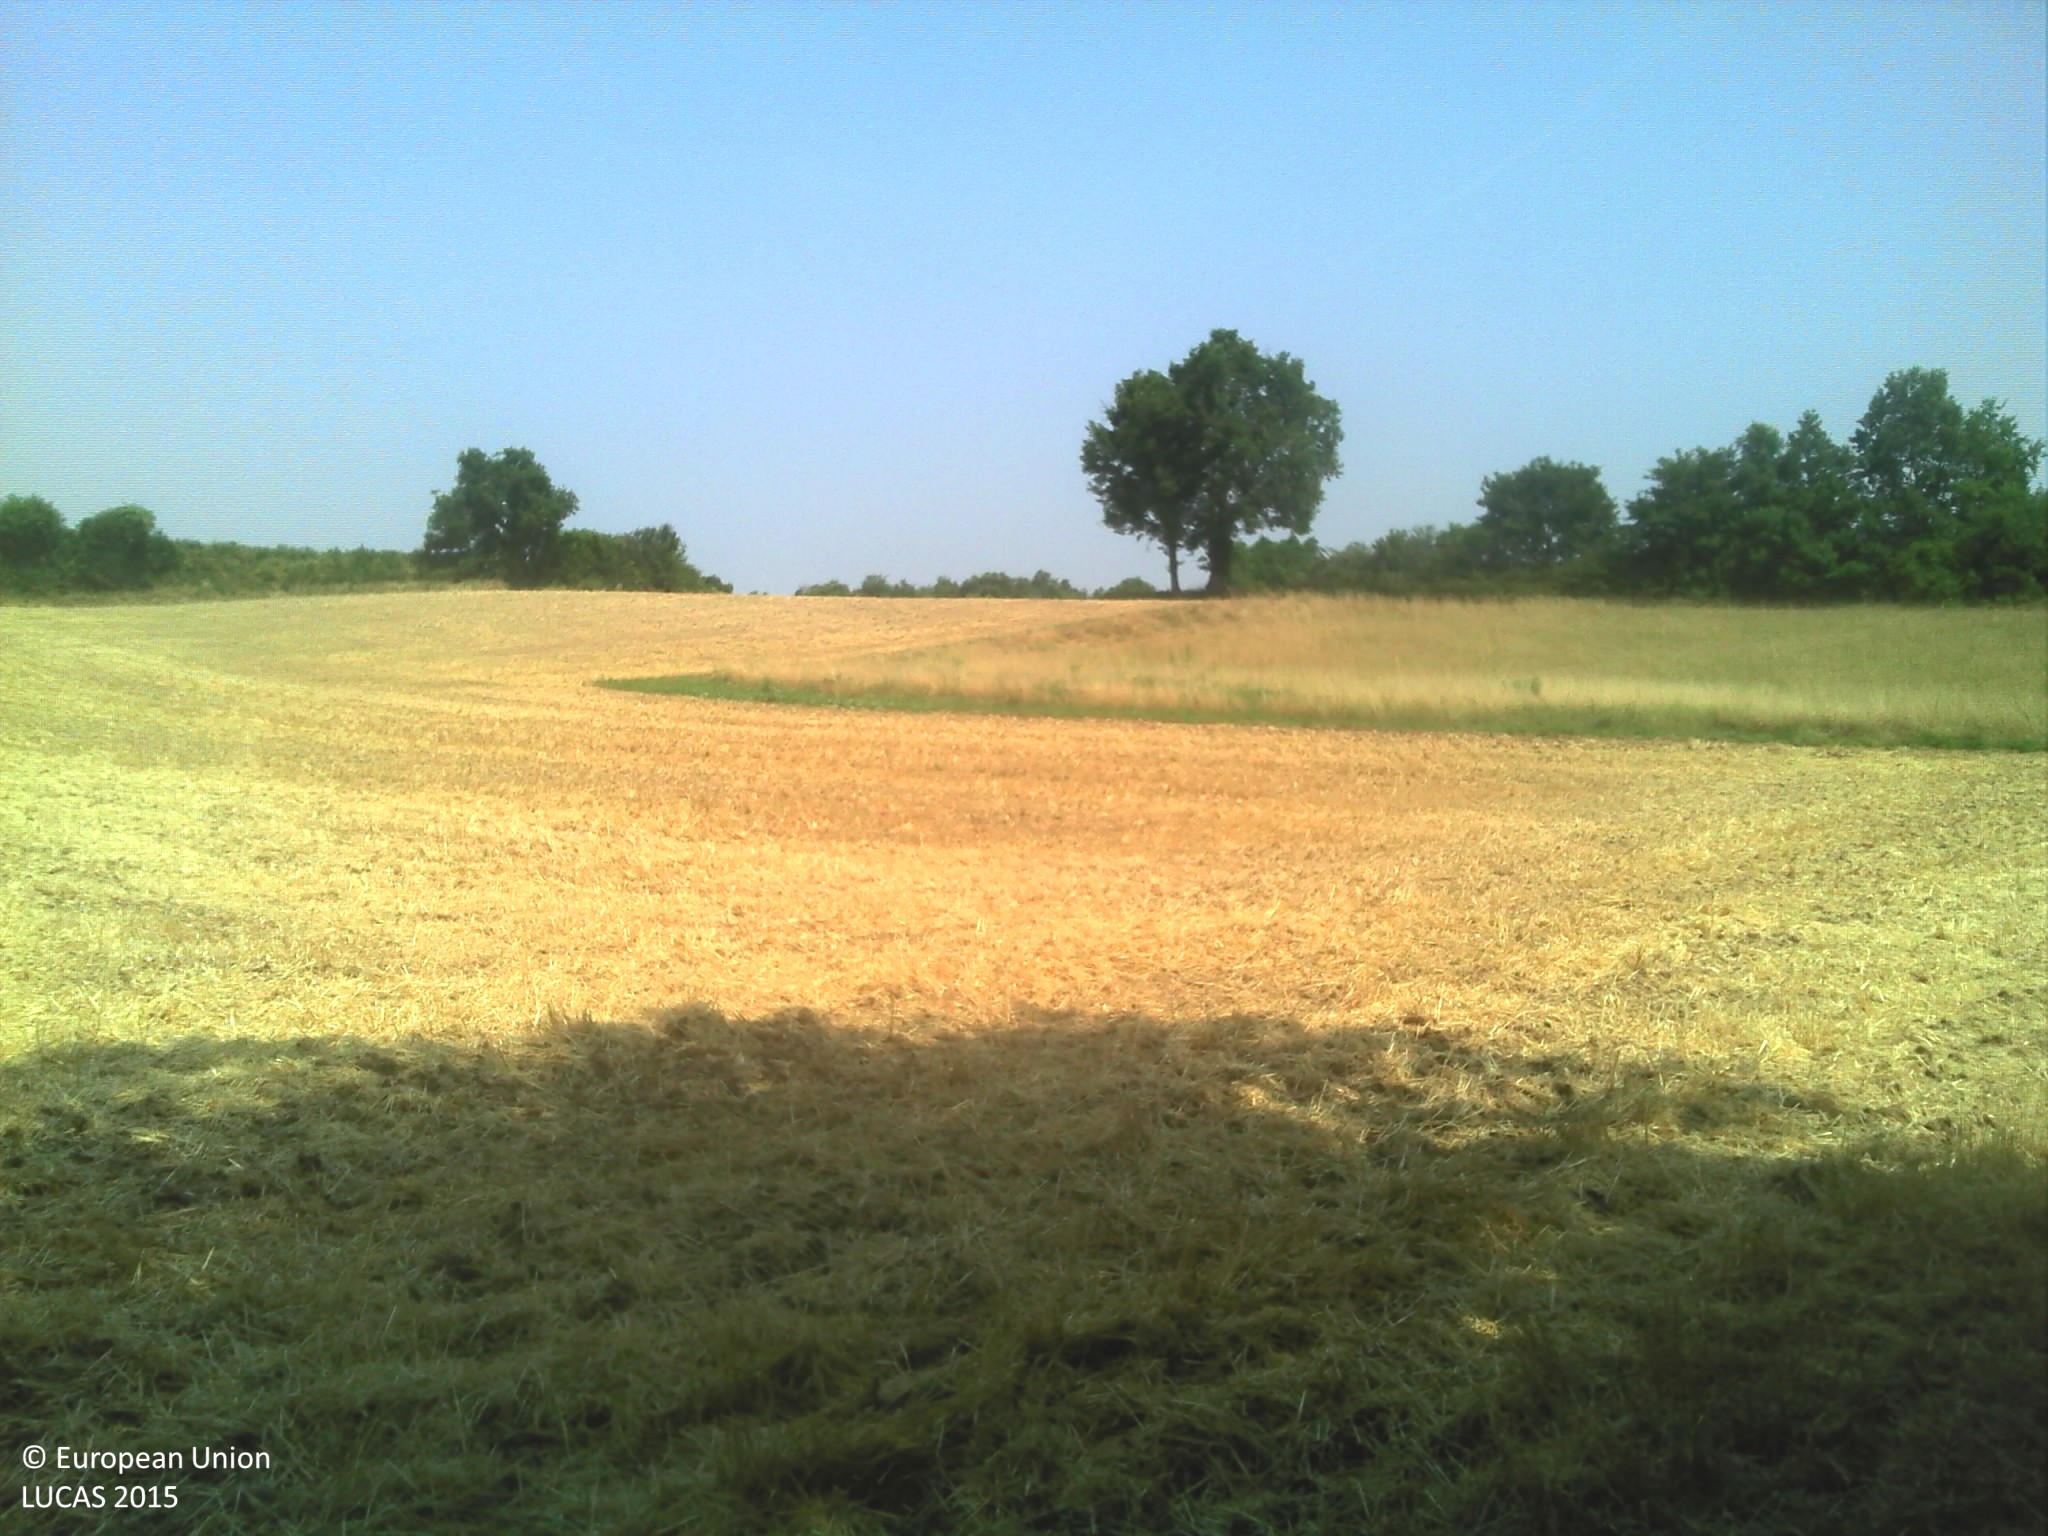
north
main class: Cropland
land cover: Common wheat
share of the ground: > 75 %
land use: Agriculture (excluding fallow land and kitchen gardens)
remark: Harvested field
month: July
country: FR
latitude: 45.7903
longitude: 5.1541
